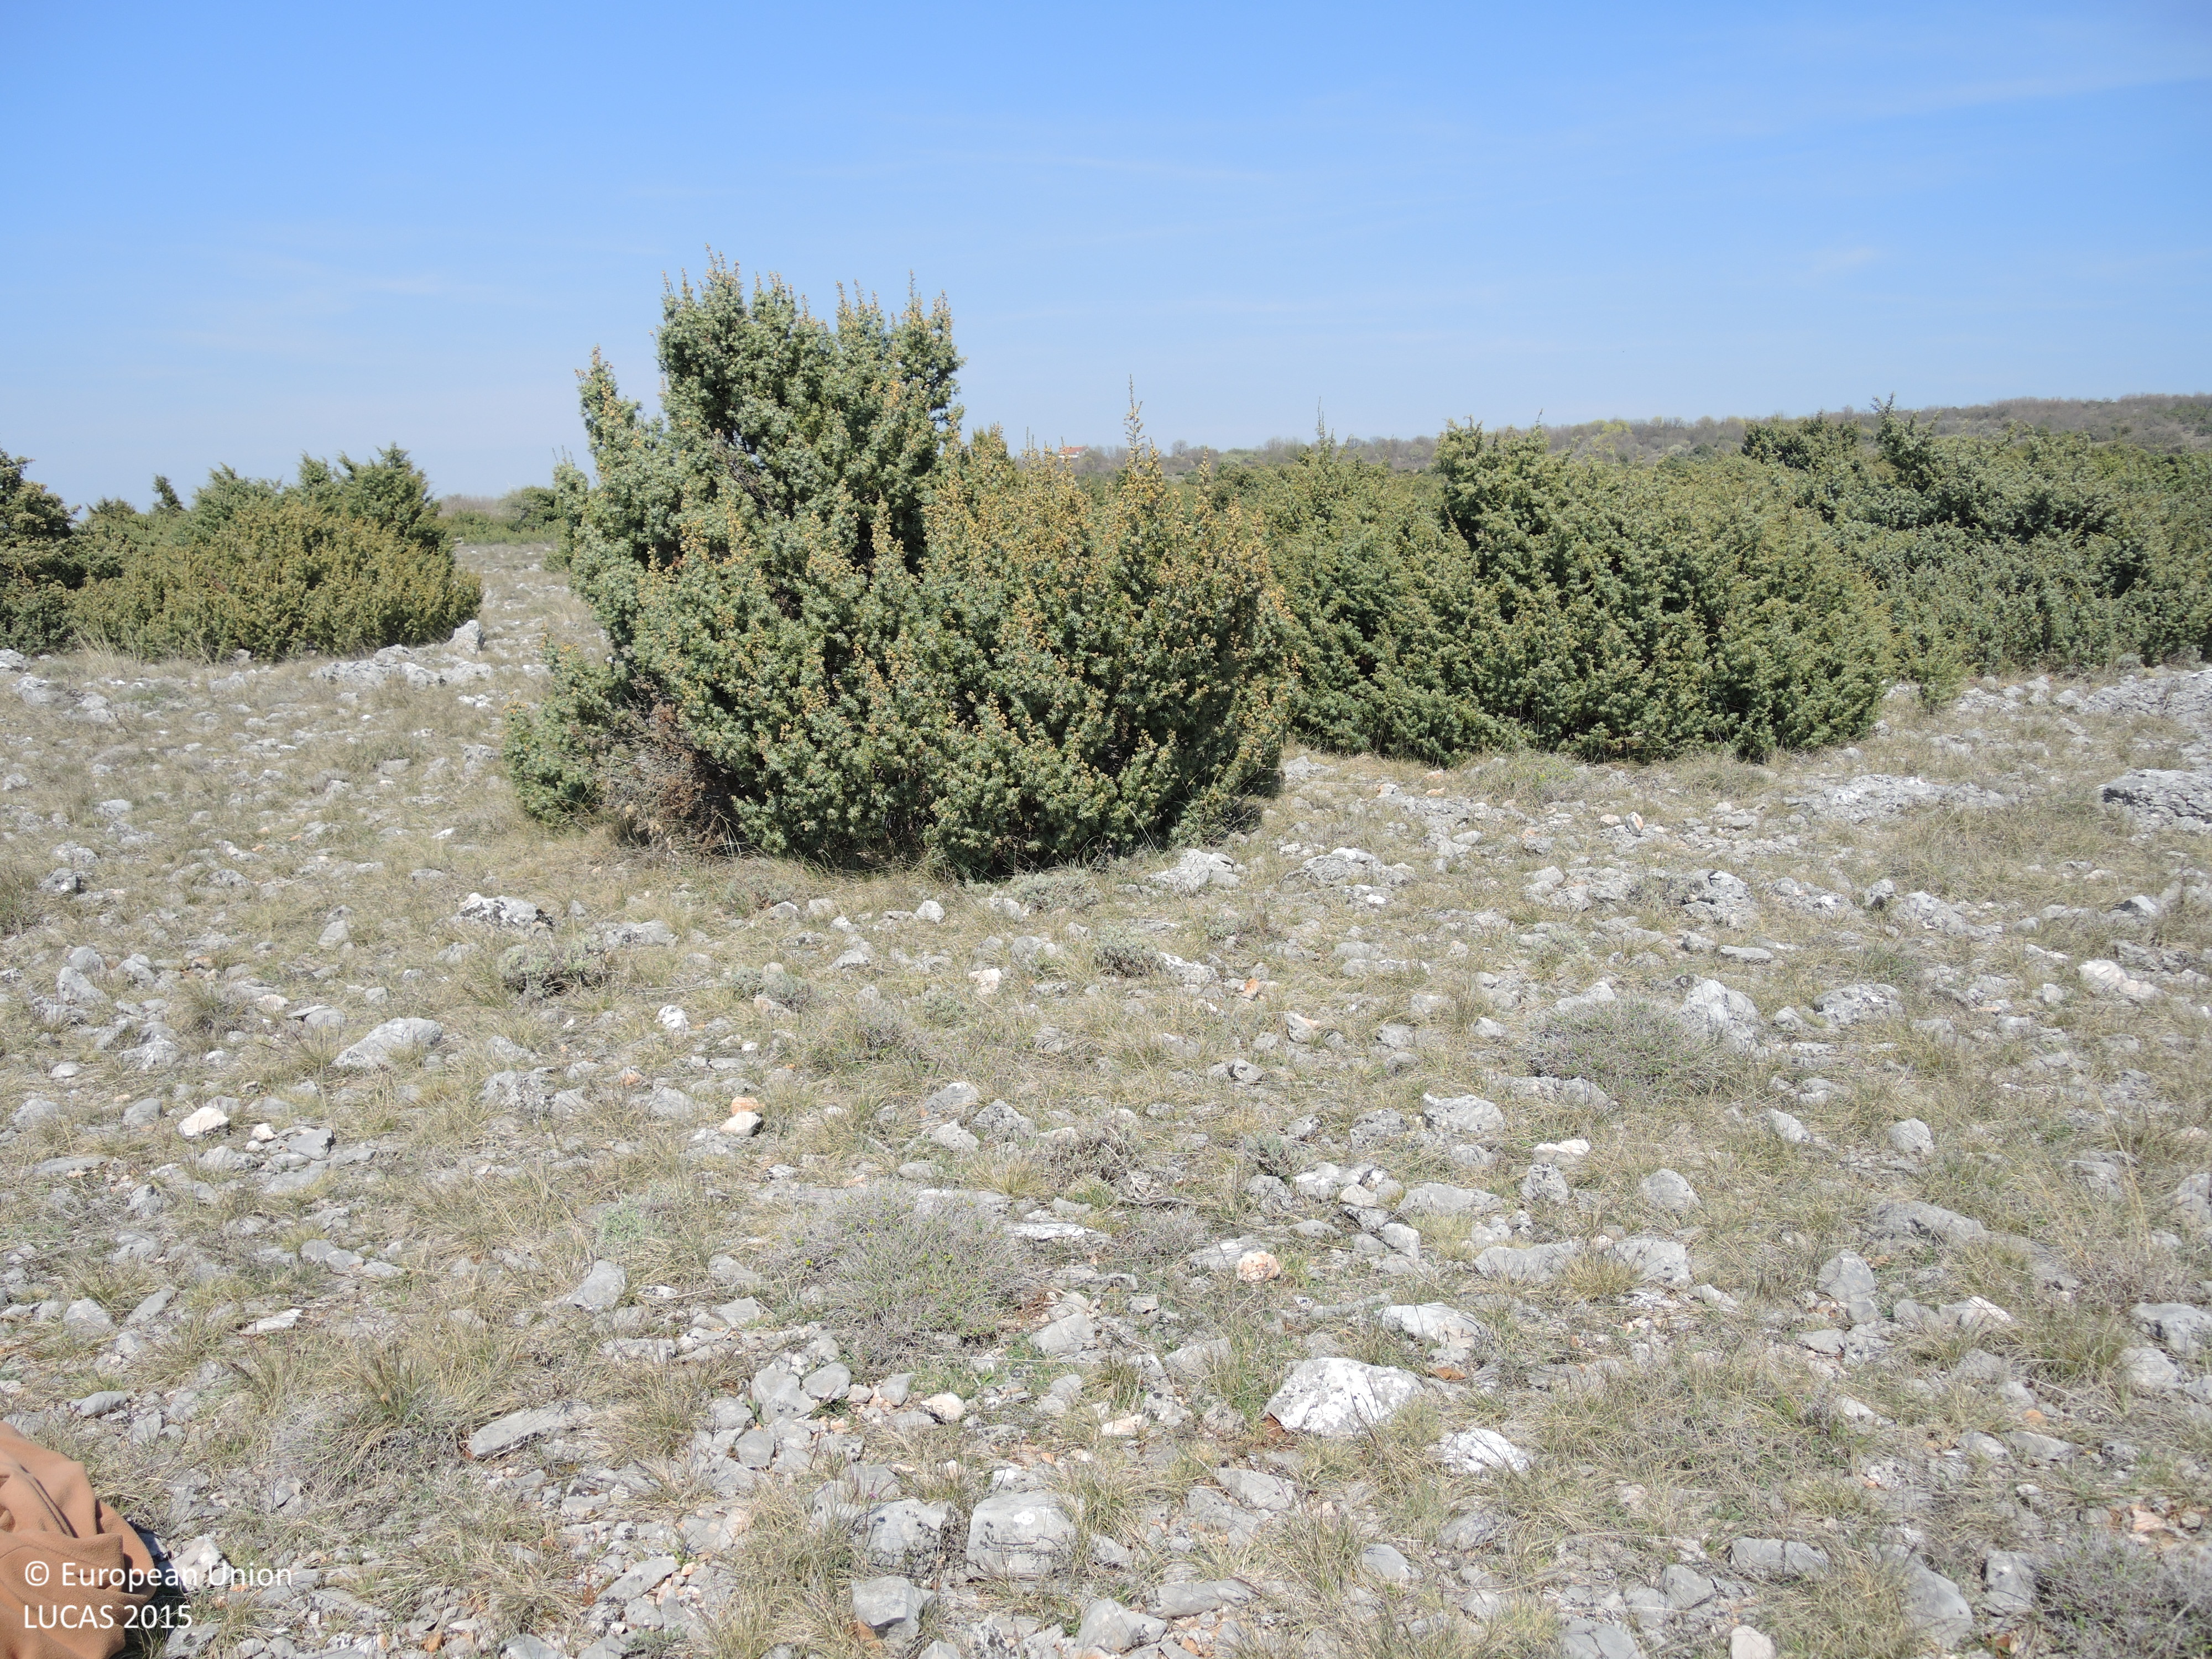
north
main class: Shrubland
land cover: Shrubland without tree cover
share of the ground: 10 - 25 %
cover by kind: unconsolidated bare surface 45 %, herbaceous plants 30 %, shrubs 15 %, consolidated bare surface 10 %
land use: Semi-natural and natural areas not in use
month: April
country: HR
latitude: 44.0135
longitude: 15.6924
